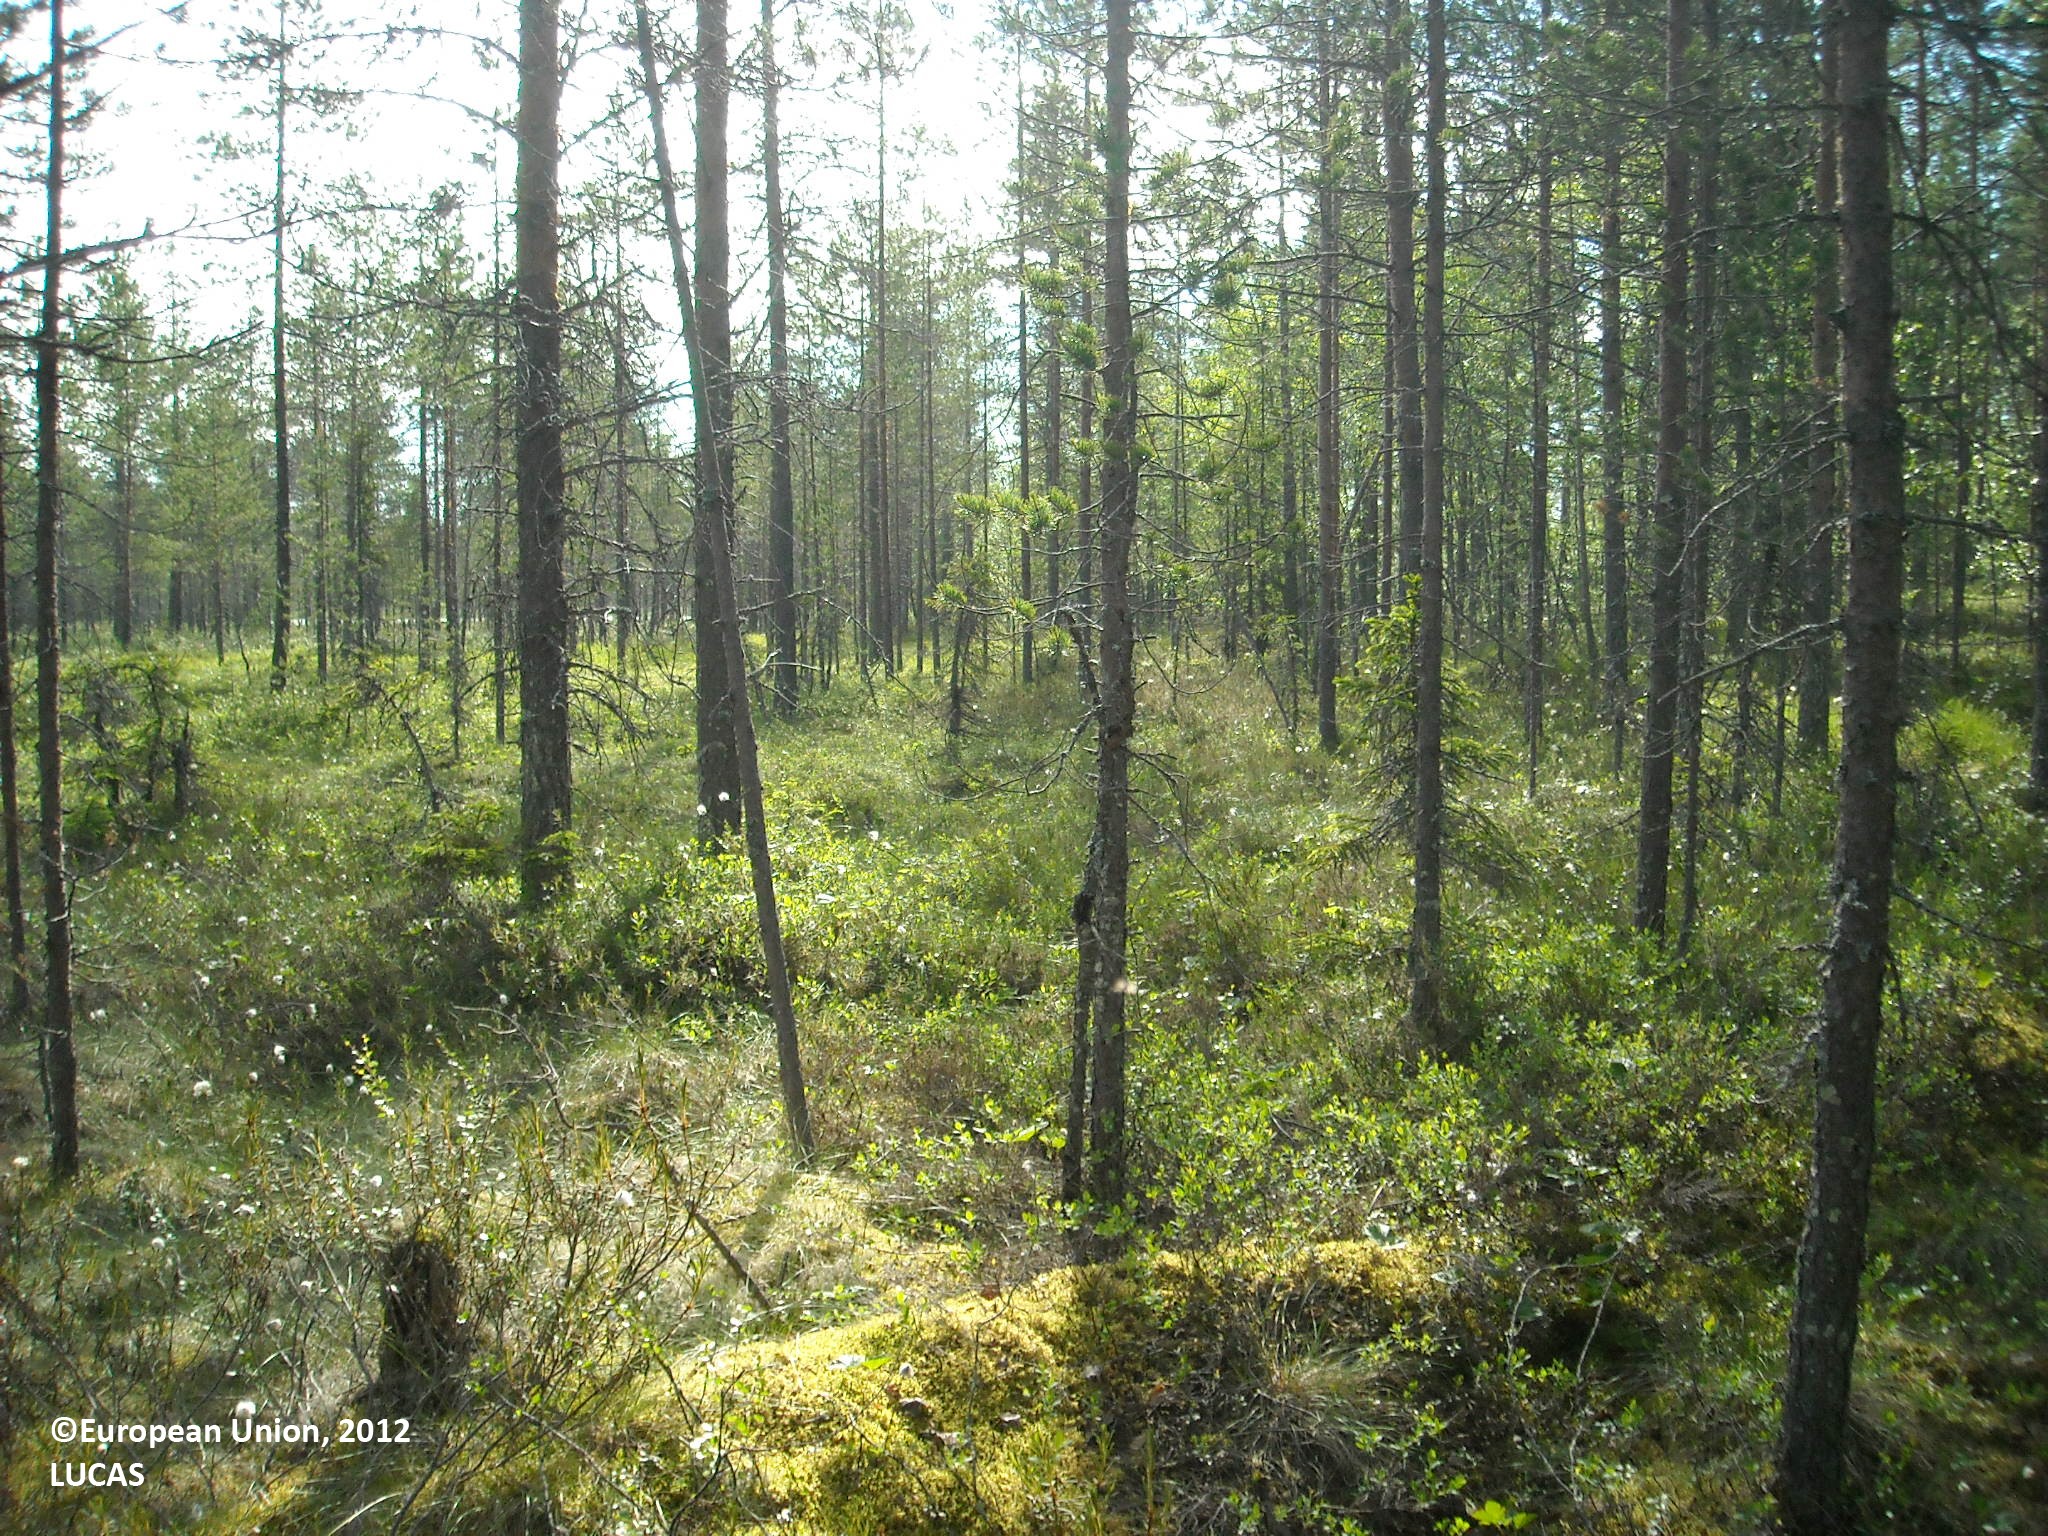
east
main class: Woodland
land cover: Pine dominated coniferous woodland
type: mire and swamp forests
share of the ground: > 75 %
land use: Forestry
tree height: > 5 m
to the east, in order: Pine dominated coniferous woodland; Ditches and canals; Pine dominated coniferous woodland; Ditches and canals; Pine dominated coniferous woodland; Peatbogs
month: July
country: FI
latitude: 64.6505
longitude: 27.7542
